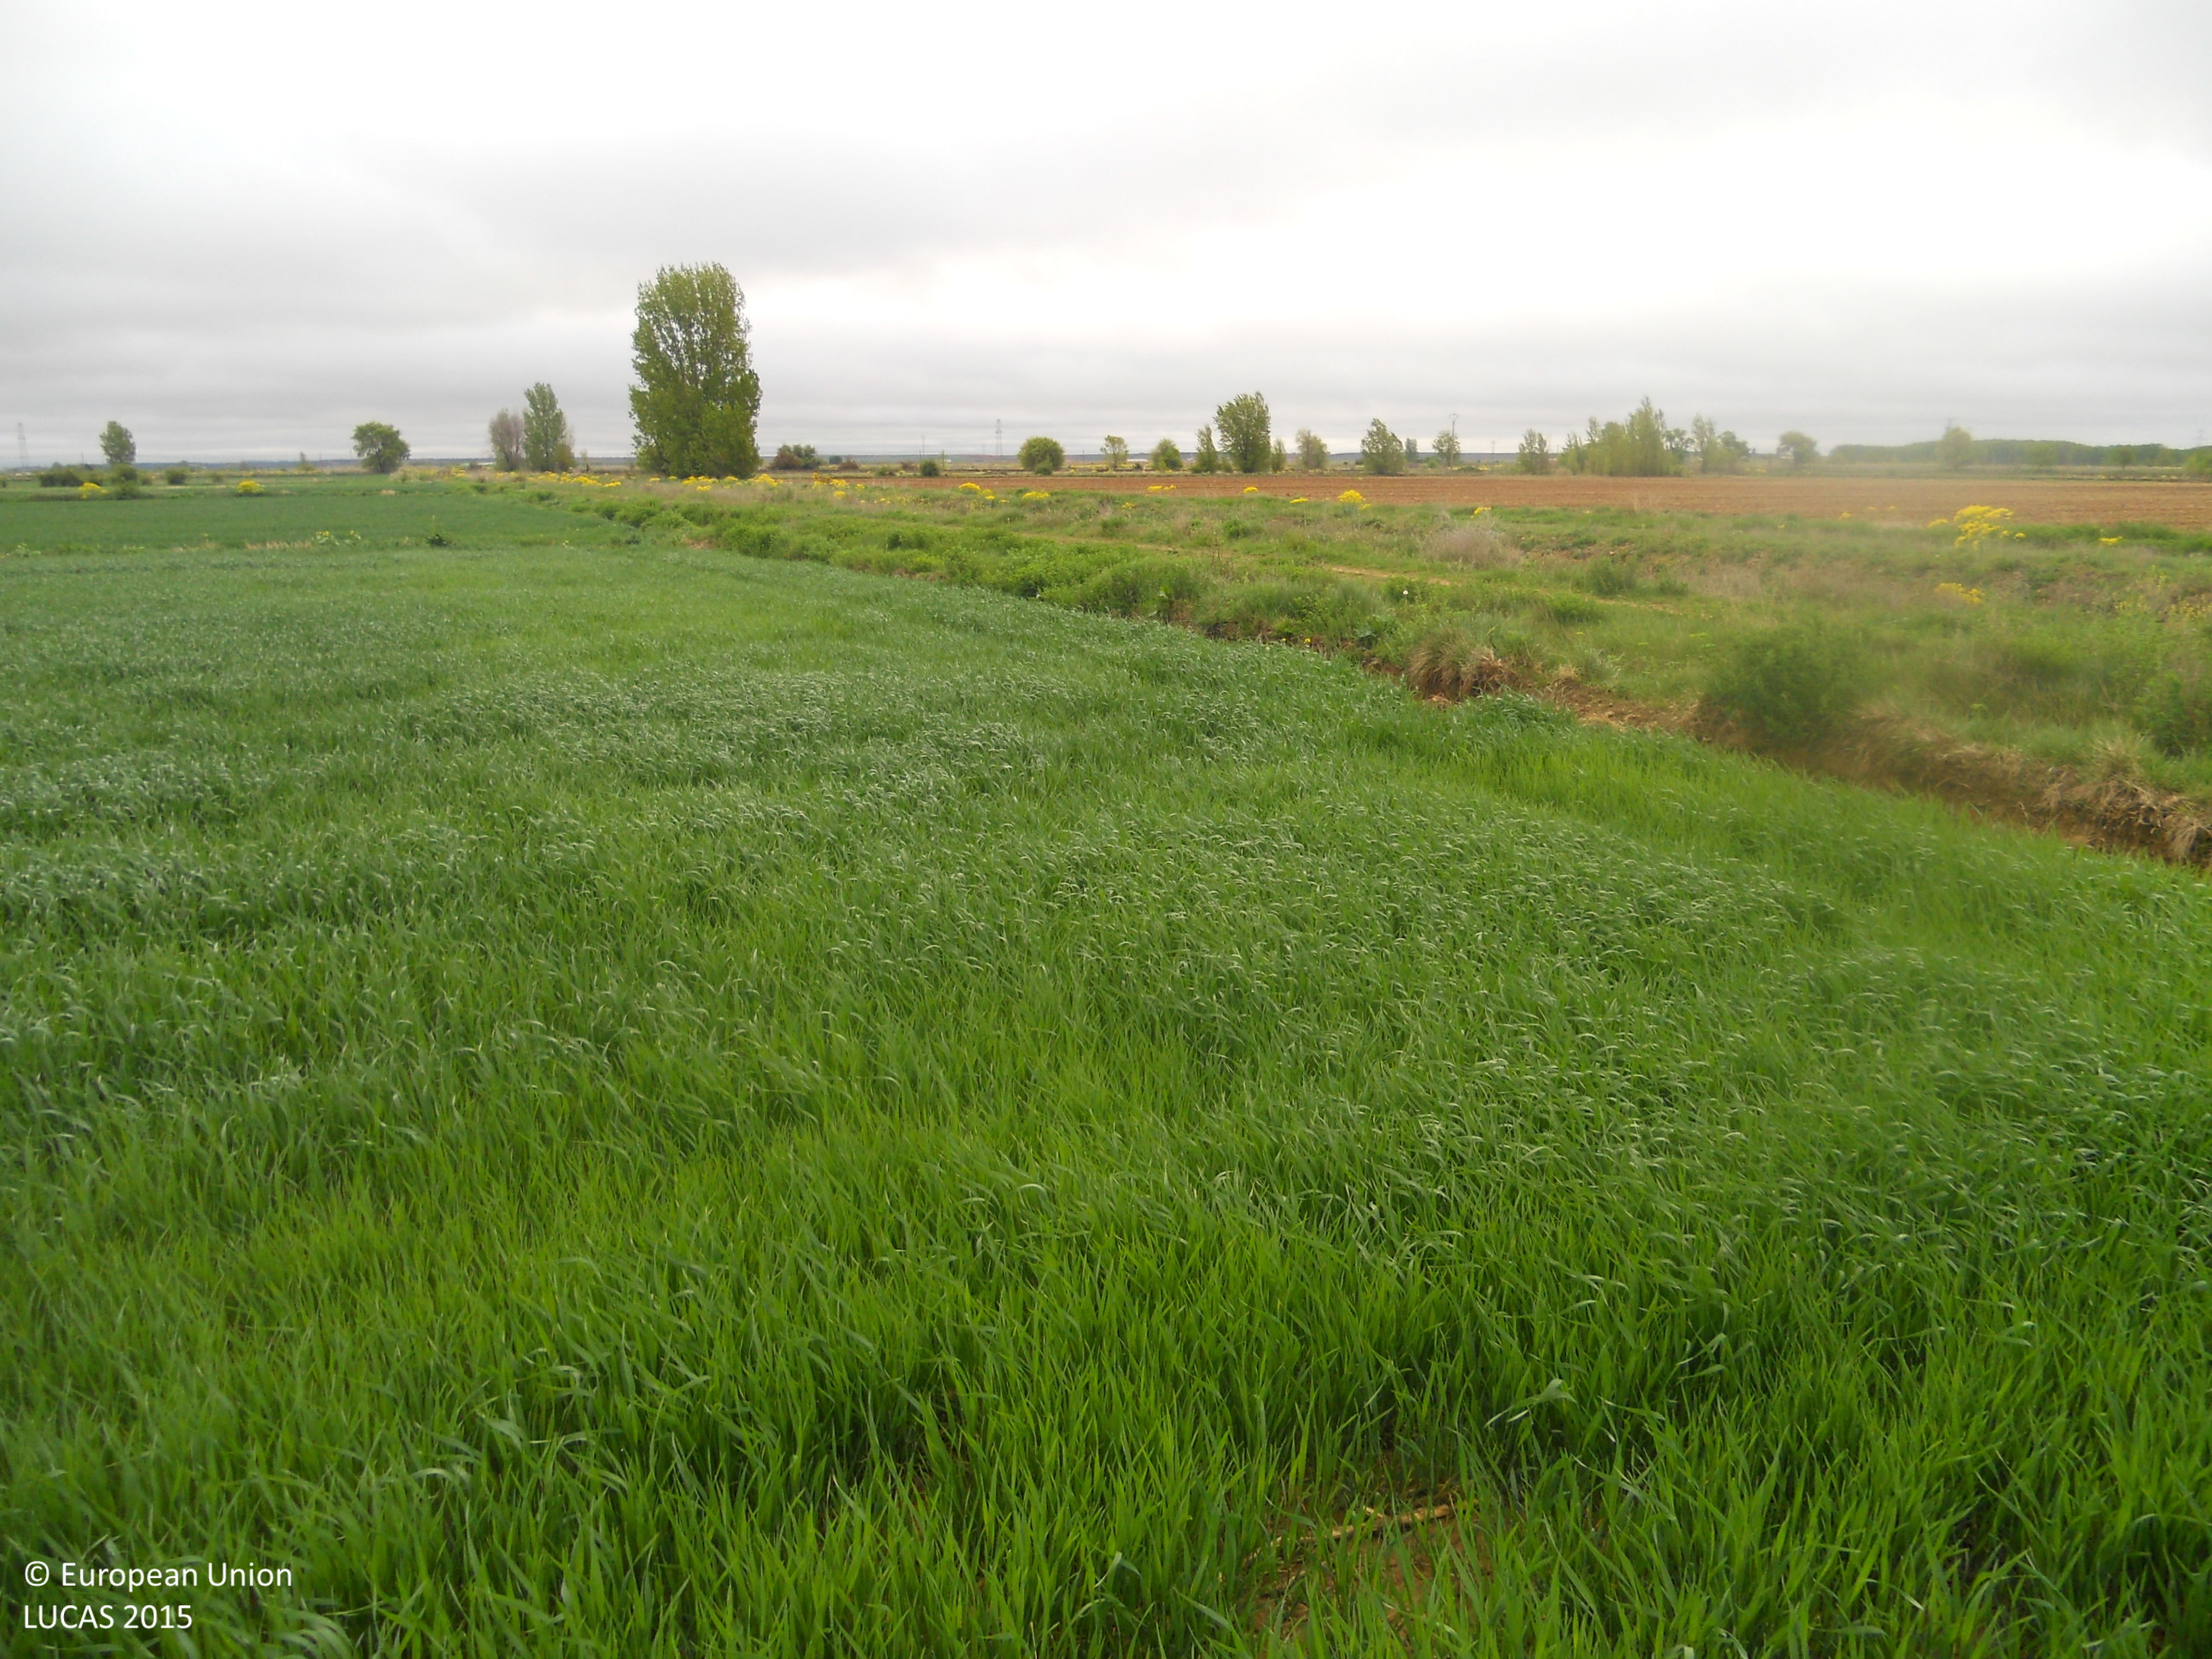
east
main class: Cropland
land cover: Common wheat
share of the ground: > 75 %
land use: Agriculture (excluding fallow land and kitchen gardens)
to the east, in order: Grass margins; Common wheat; Grass margins; Rivers and streams; Grass margins; Tracks; Grass margins; Rivers and streams; Grass margins; Tracks; Grass margins; Rivers and streams; Maize
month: May
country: ES
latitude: 42.4763
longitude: -5.4067
